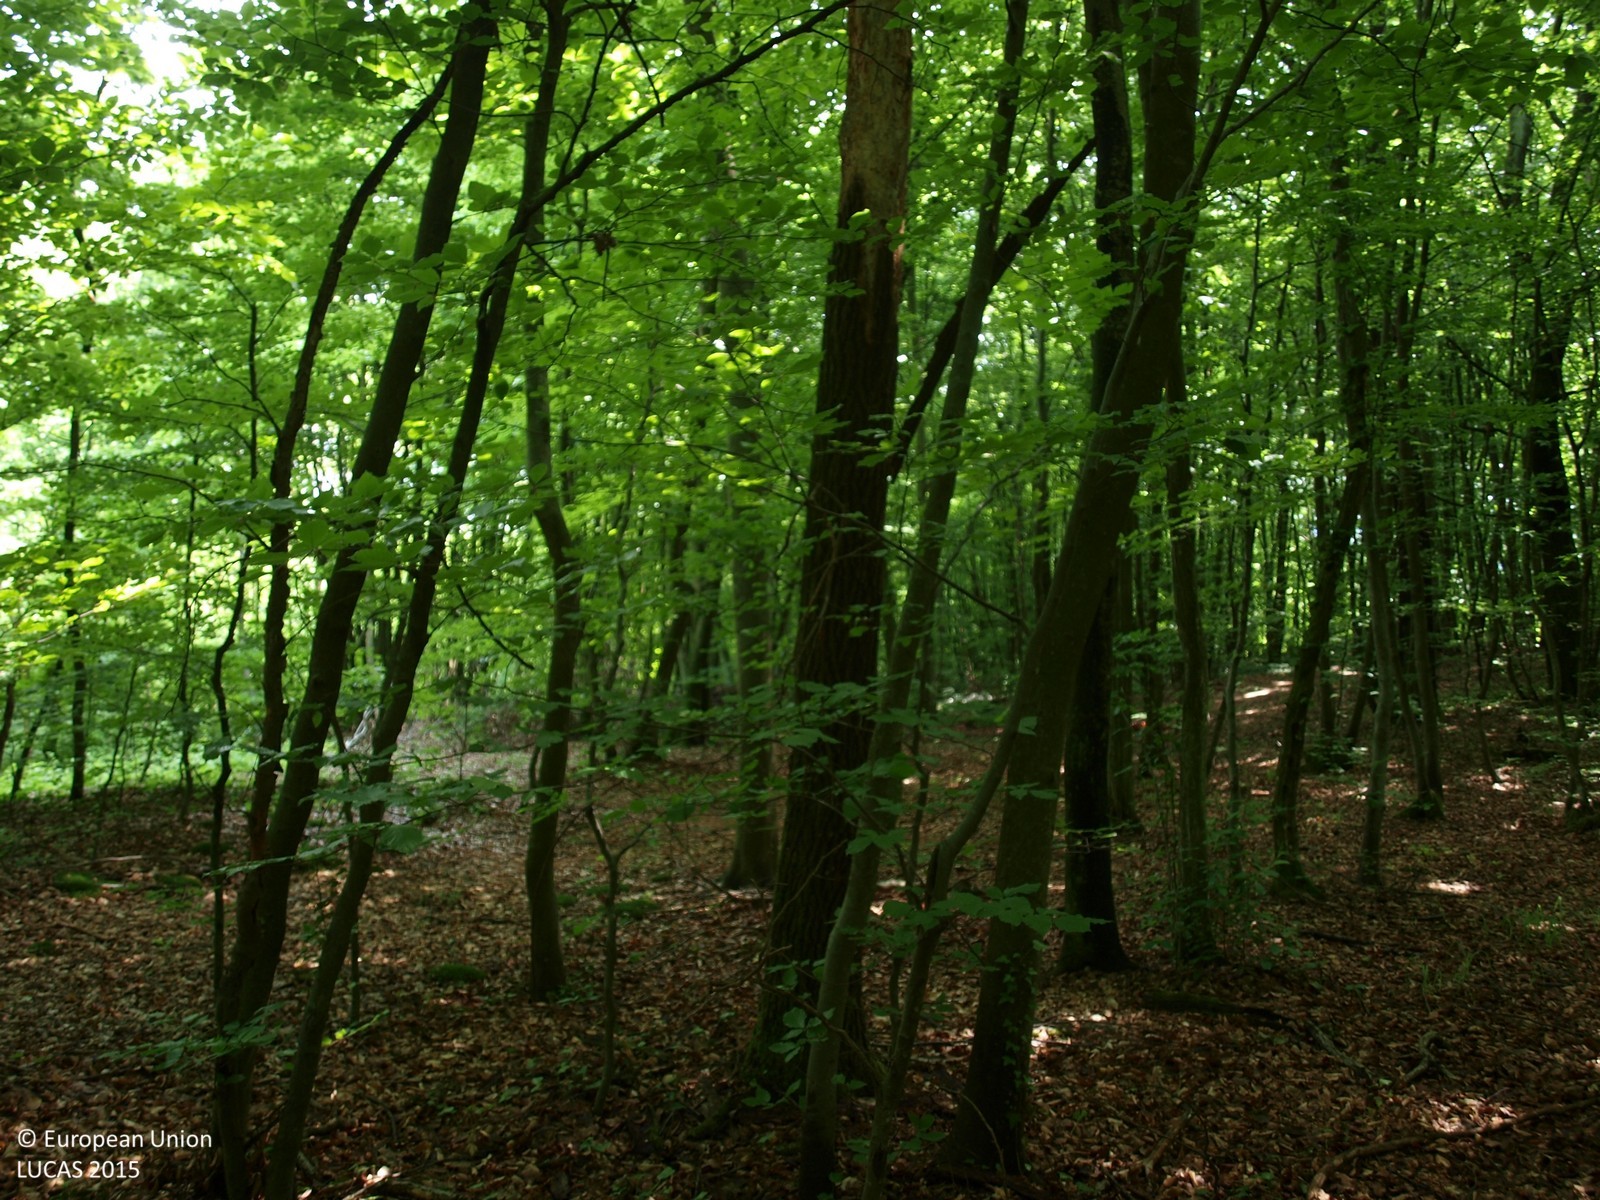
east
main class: Woodland
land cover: Broadleaved woodland
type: mesophytic deciduous forest
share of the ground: > 75 %
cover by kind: broadleaved forest trees 95 %, shrubs 5 %
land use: Forestry
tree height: > 5 m
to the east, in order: Broadleaved woodland; Tracks; Broadleaved woodland; Spontaneously vegetated surfaces; Broadleaved woodland; Grassland without tree/shrub cover; Single bushes/trees; Maize; Grassland without tree/shrub cover; Electric lines; Grassland without tree/shrub cover
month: May
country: HR
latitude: 46.0799
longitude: 16.2190
